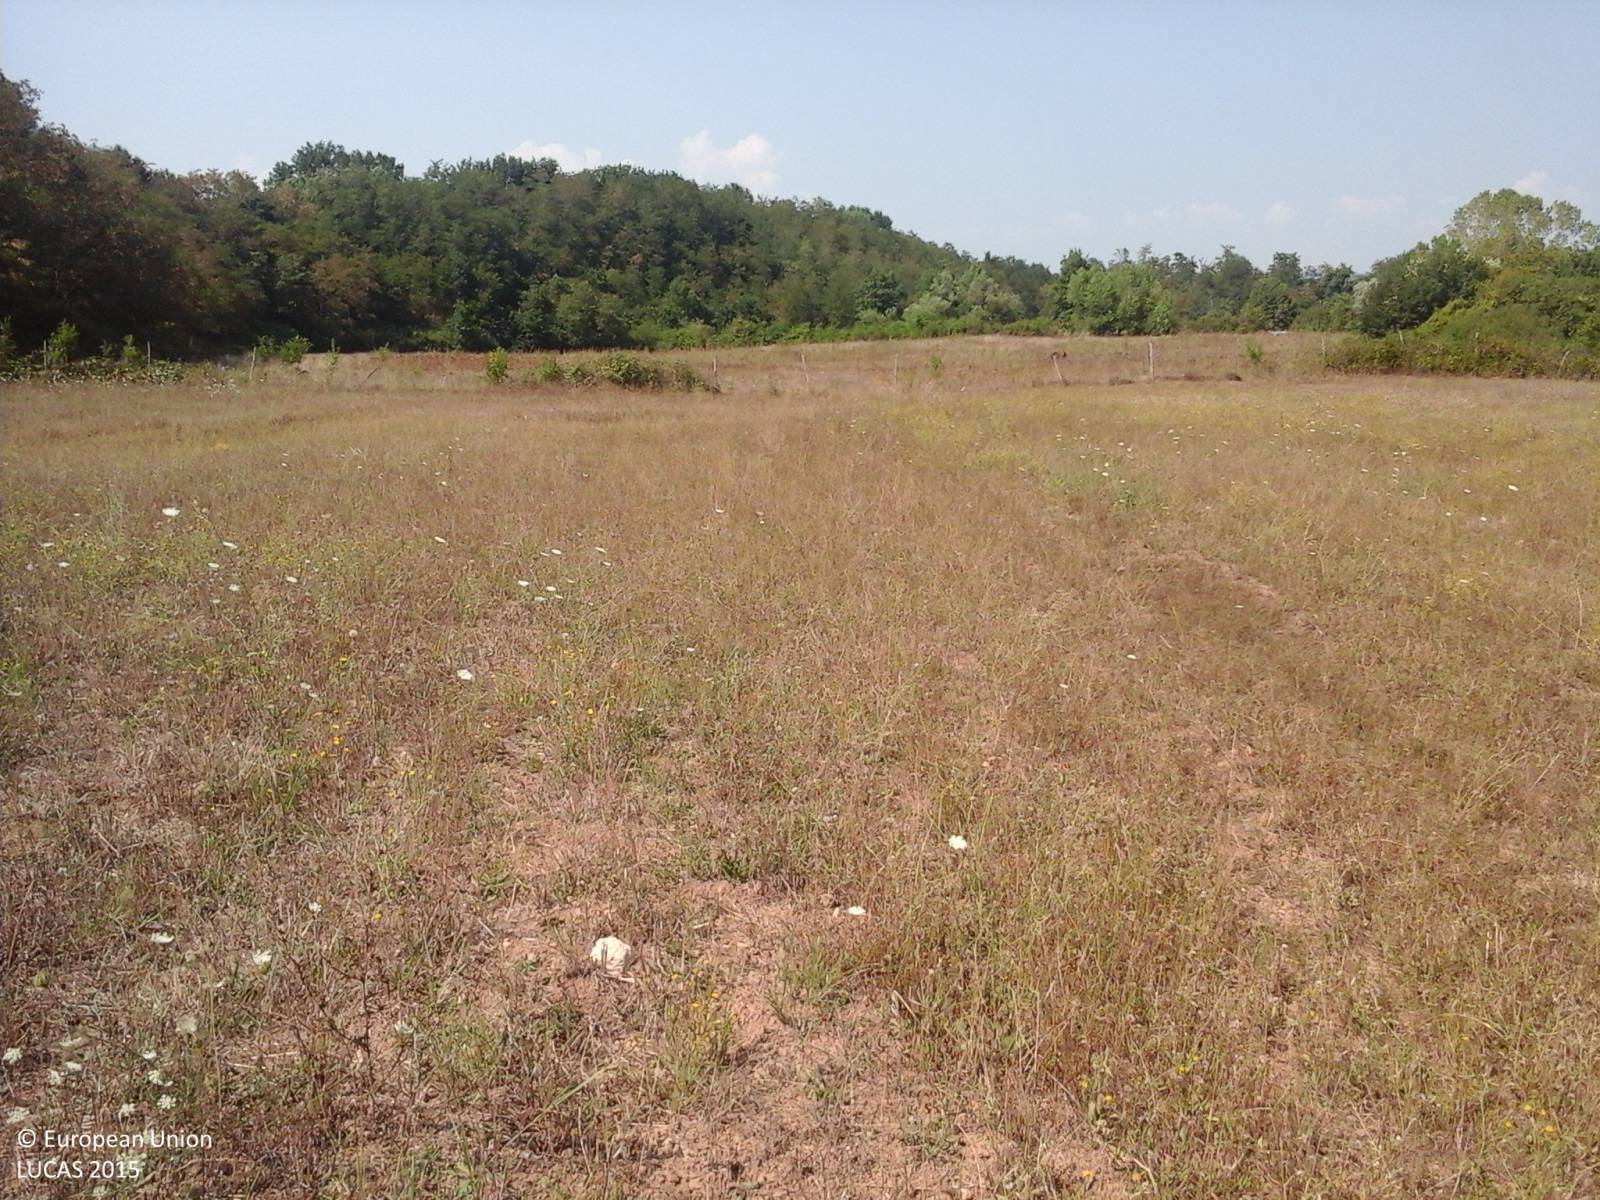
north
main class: Cropland
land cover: Mixed cereals for fodder
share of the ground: > 75 %
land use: Agriculture (excluding fallow land and kitchen gardens)
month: August
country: IT
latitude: 42.2350
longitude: 12.0889
